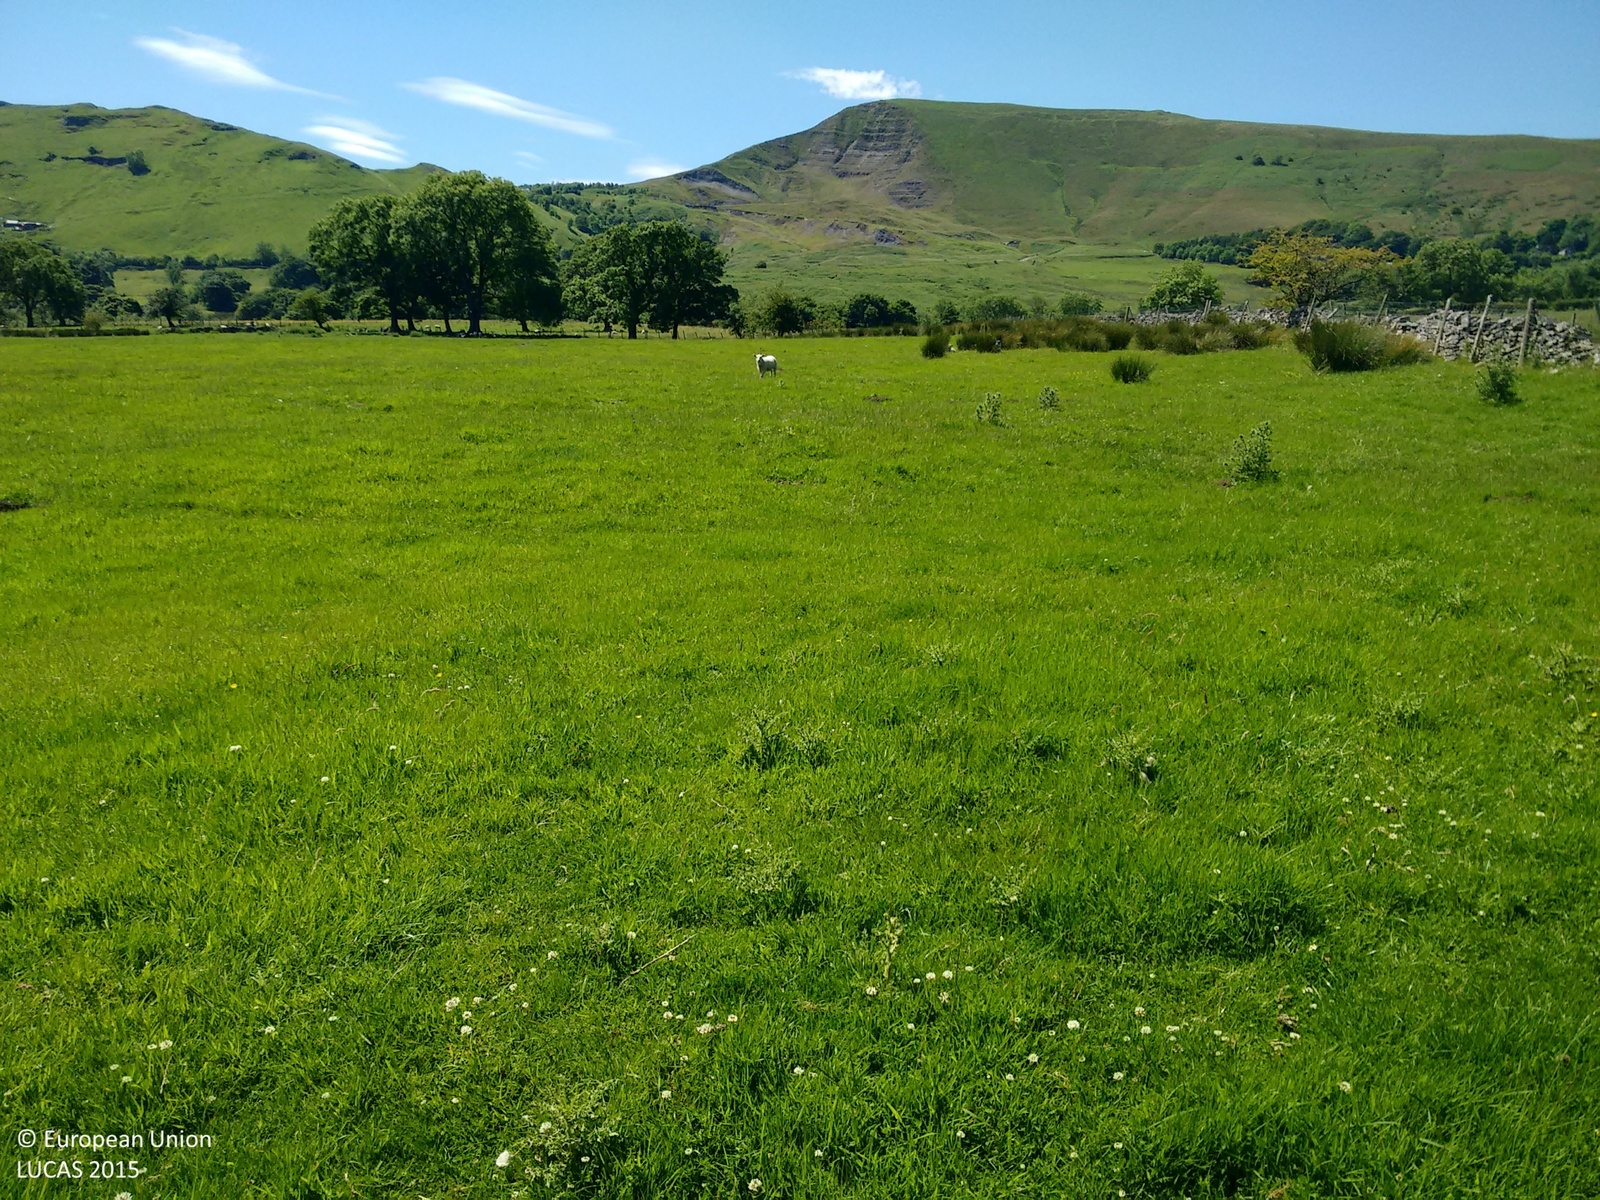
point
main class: Grassland
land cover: Grassland without tree/shrub cover
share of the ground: > 75 %
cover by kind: herbaceous plants 100 %
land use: Agriculture (excluding fallow land and kitchen gardens)
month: June
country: GB
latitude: 53.3510
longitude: -1.7872
